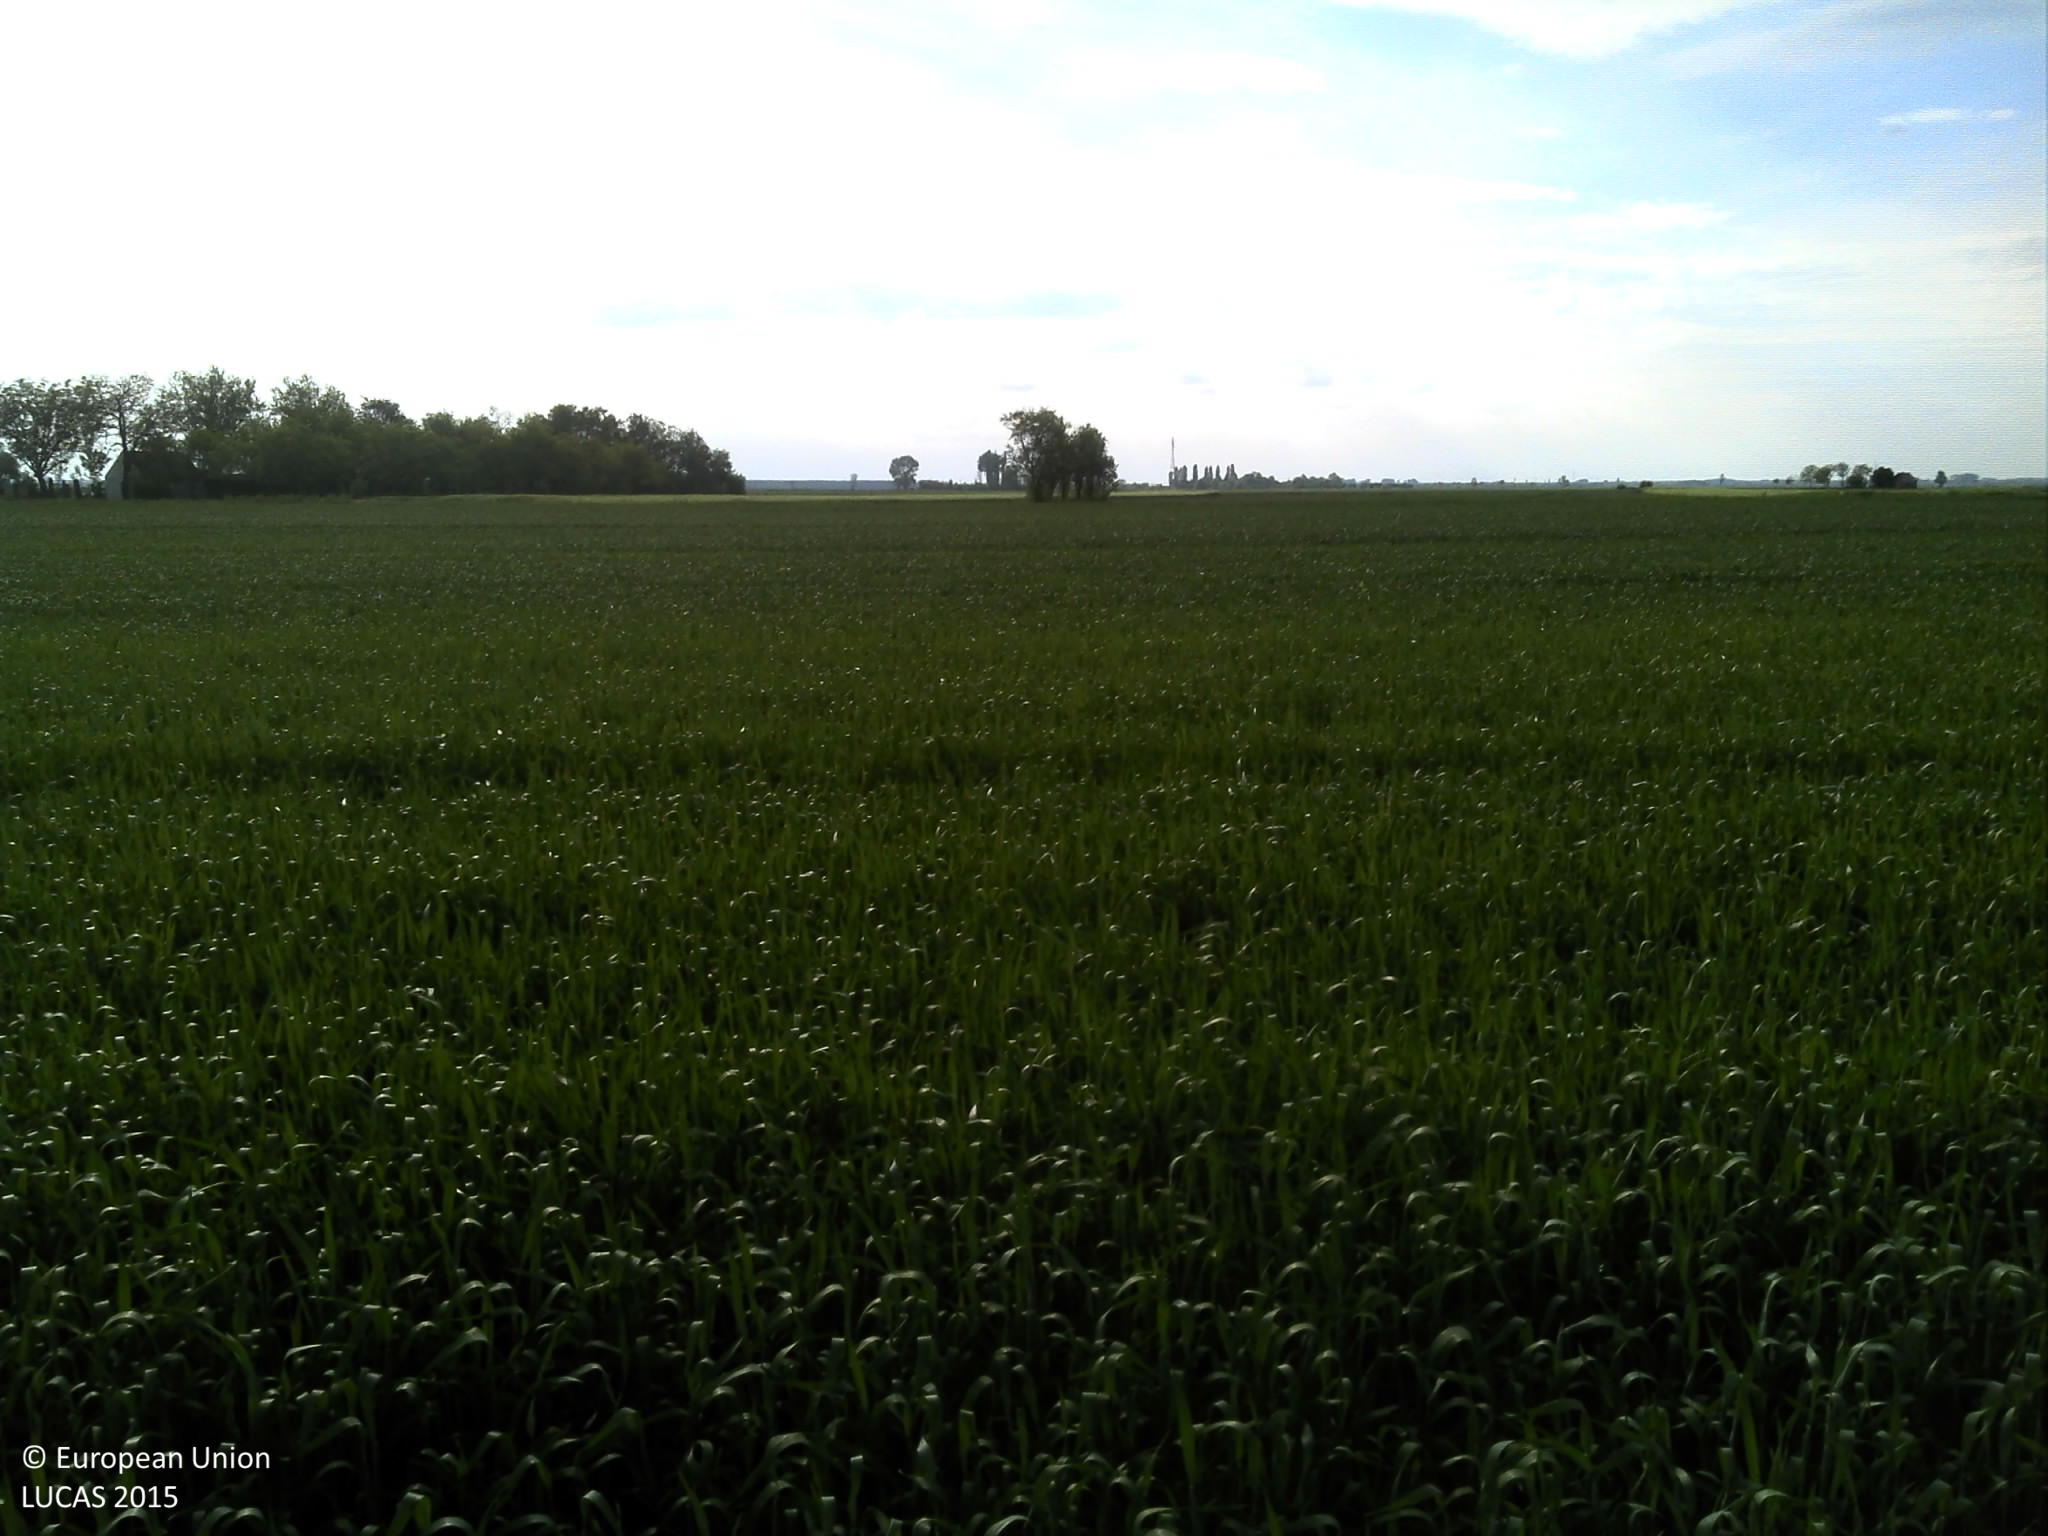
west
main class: Cropland
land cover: Common wheat
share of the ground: > 75 %
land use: Agriculture (excluding fallow land and kitchen gardens)
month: May
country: HR
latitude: 45.1642
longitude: 18.9001
